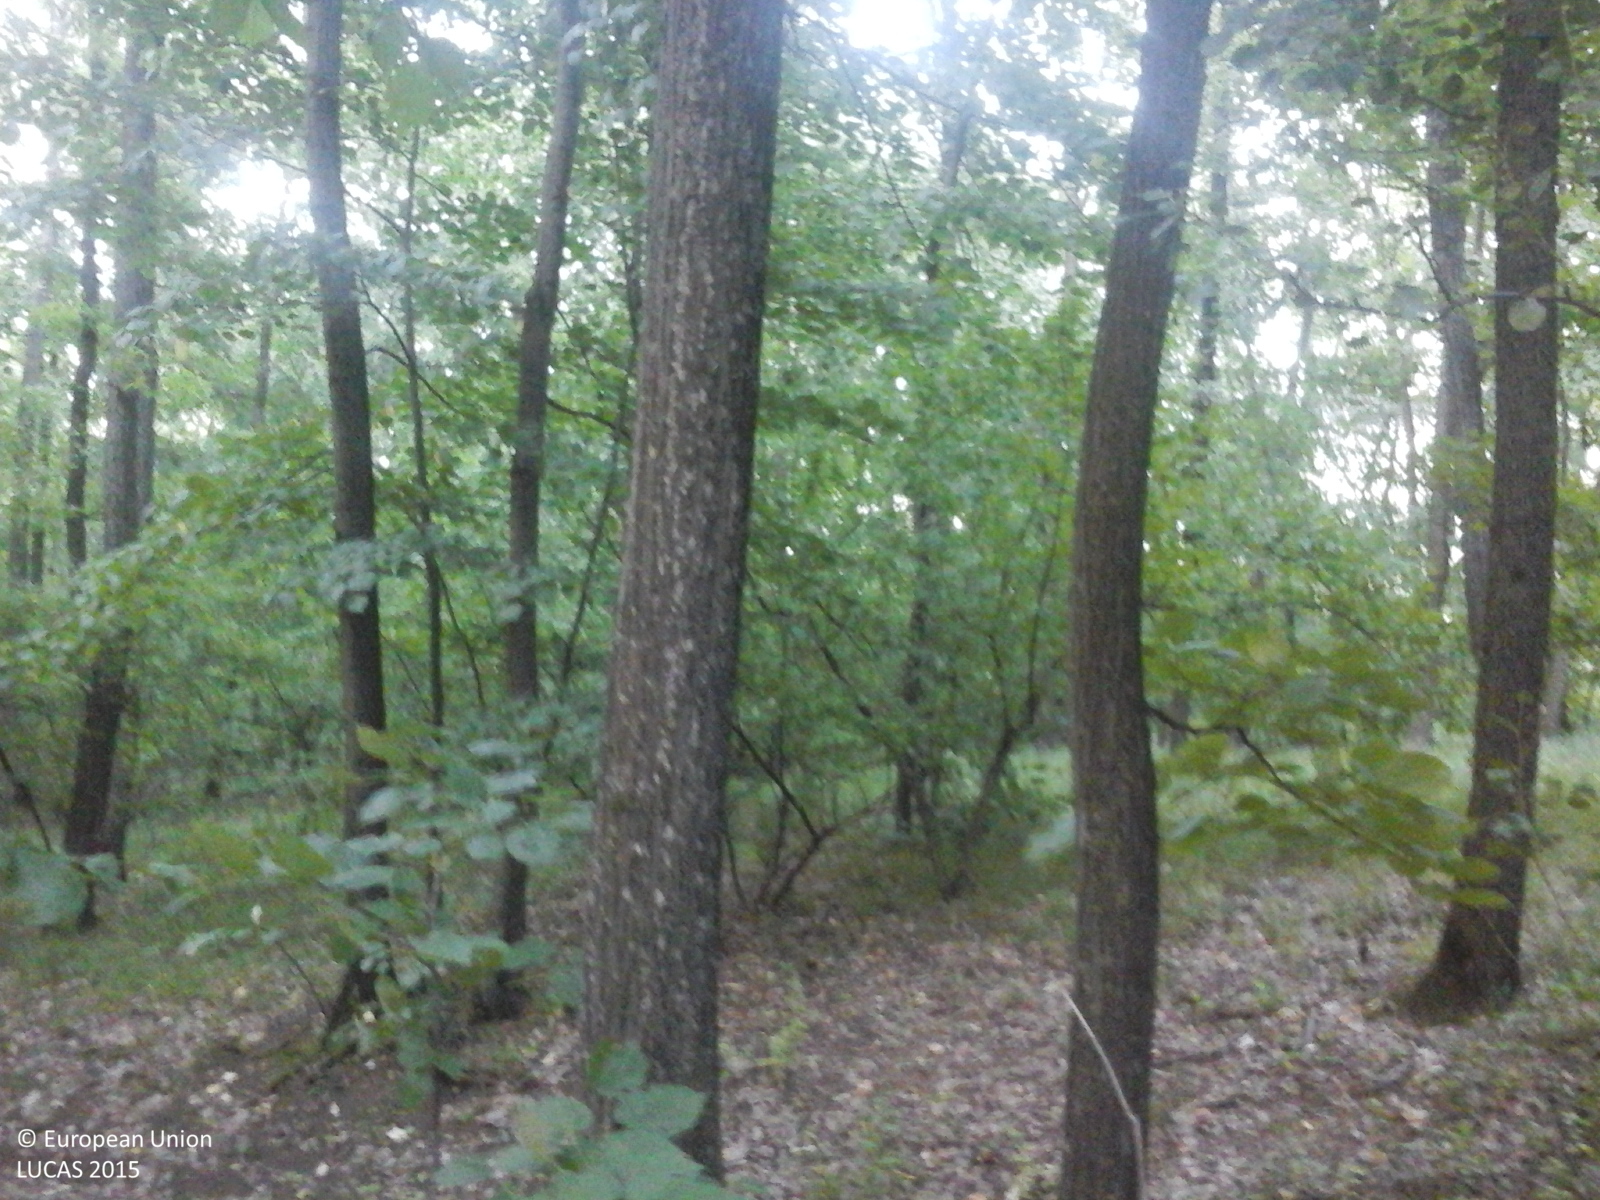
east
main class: Woodland
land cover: Broadleaved woodland
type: beech forest
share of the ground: > 75 %
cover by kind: broadleaved forest trees 100 %
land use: Forestry
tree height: > 5 m
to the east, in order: Broadleaved woodland; Tracks; Broadleaved woodland
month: June
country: RO
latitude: 47.1485
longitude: 26.9939
